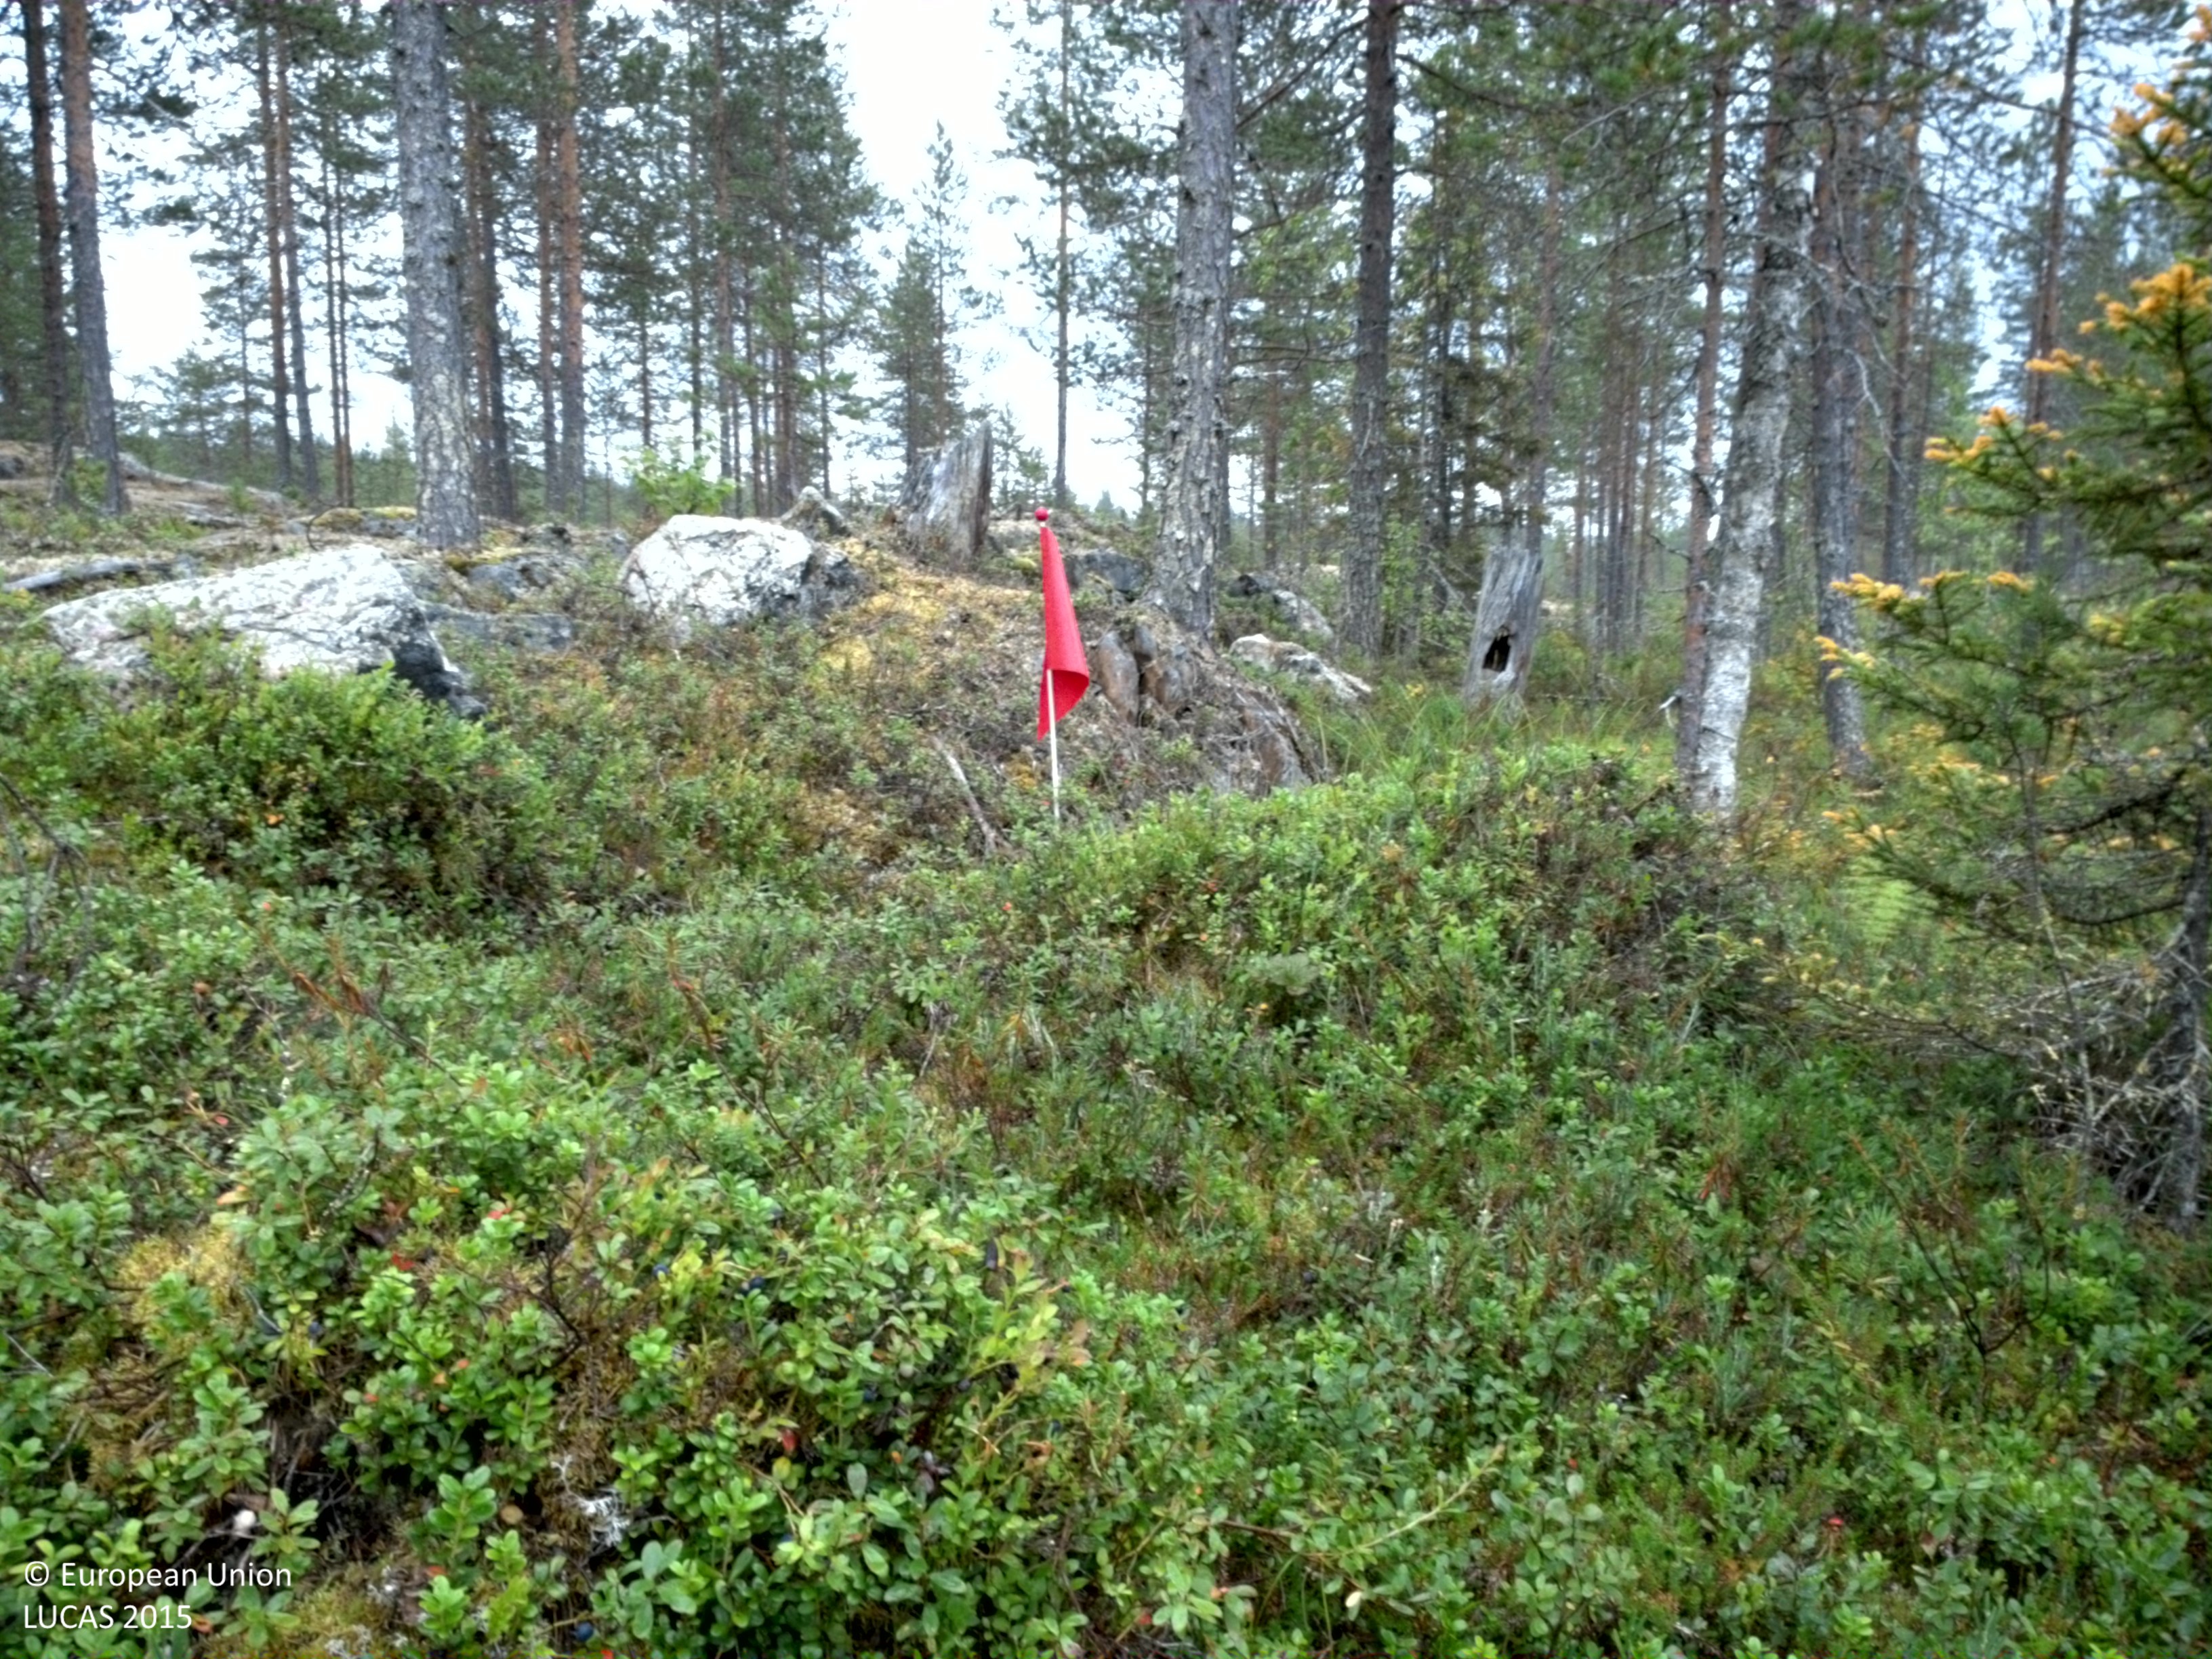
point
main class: Woodland
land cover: Pine dominated coniferous woodland
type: boreal forest
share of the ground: 25 - 50 %
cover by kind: shrubs 40 %, lichens and mosses 30 %, coniferous forest trees 25 %, consolidated bare surface 5 %
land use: Forestry
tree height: > 5 m
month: August
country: SE
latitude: 65.9620
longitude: 22.6750
